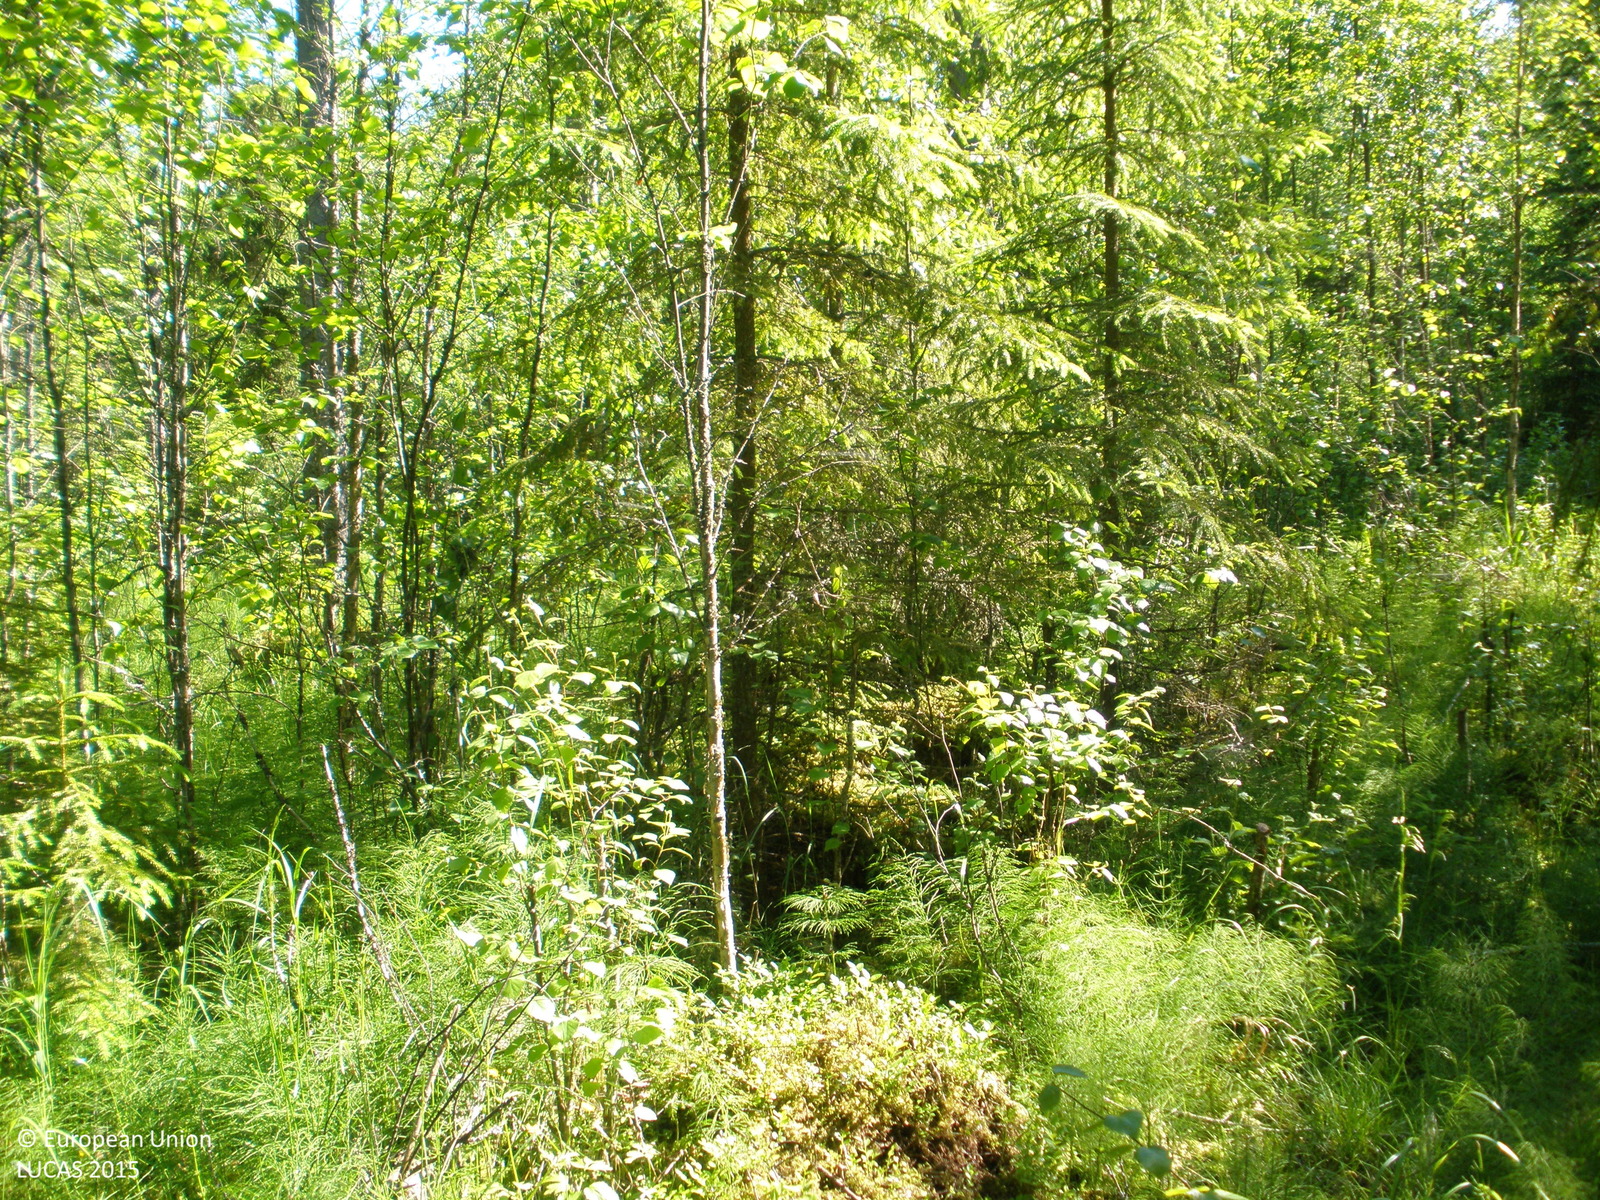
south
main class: Woodland
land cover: Spruce dominated mixed woodland
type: boreal forest
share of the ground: > 75 %
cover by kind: coniferous forest trees 60 %, broadleaved forest trees 25 %, shrubs 5 %, herbaceous plants 5 %, lichens and mosses 5 %
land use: Forestry
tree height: > 5 m
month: July
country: FI
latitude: 61.0999
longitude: 23.7200
